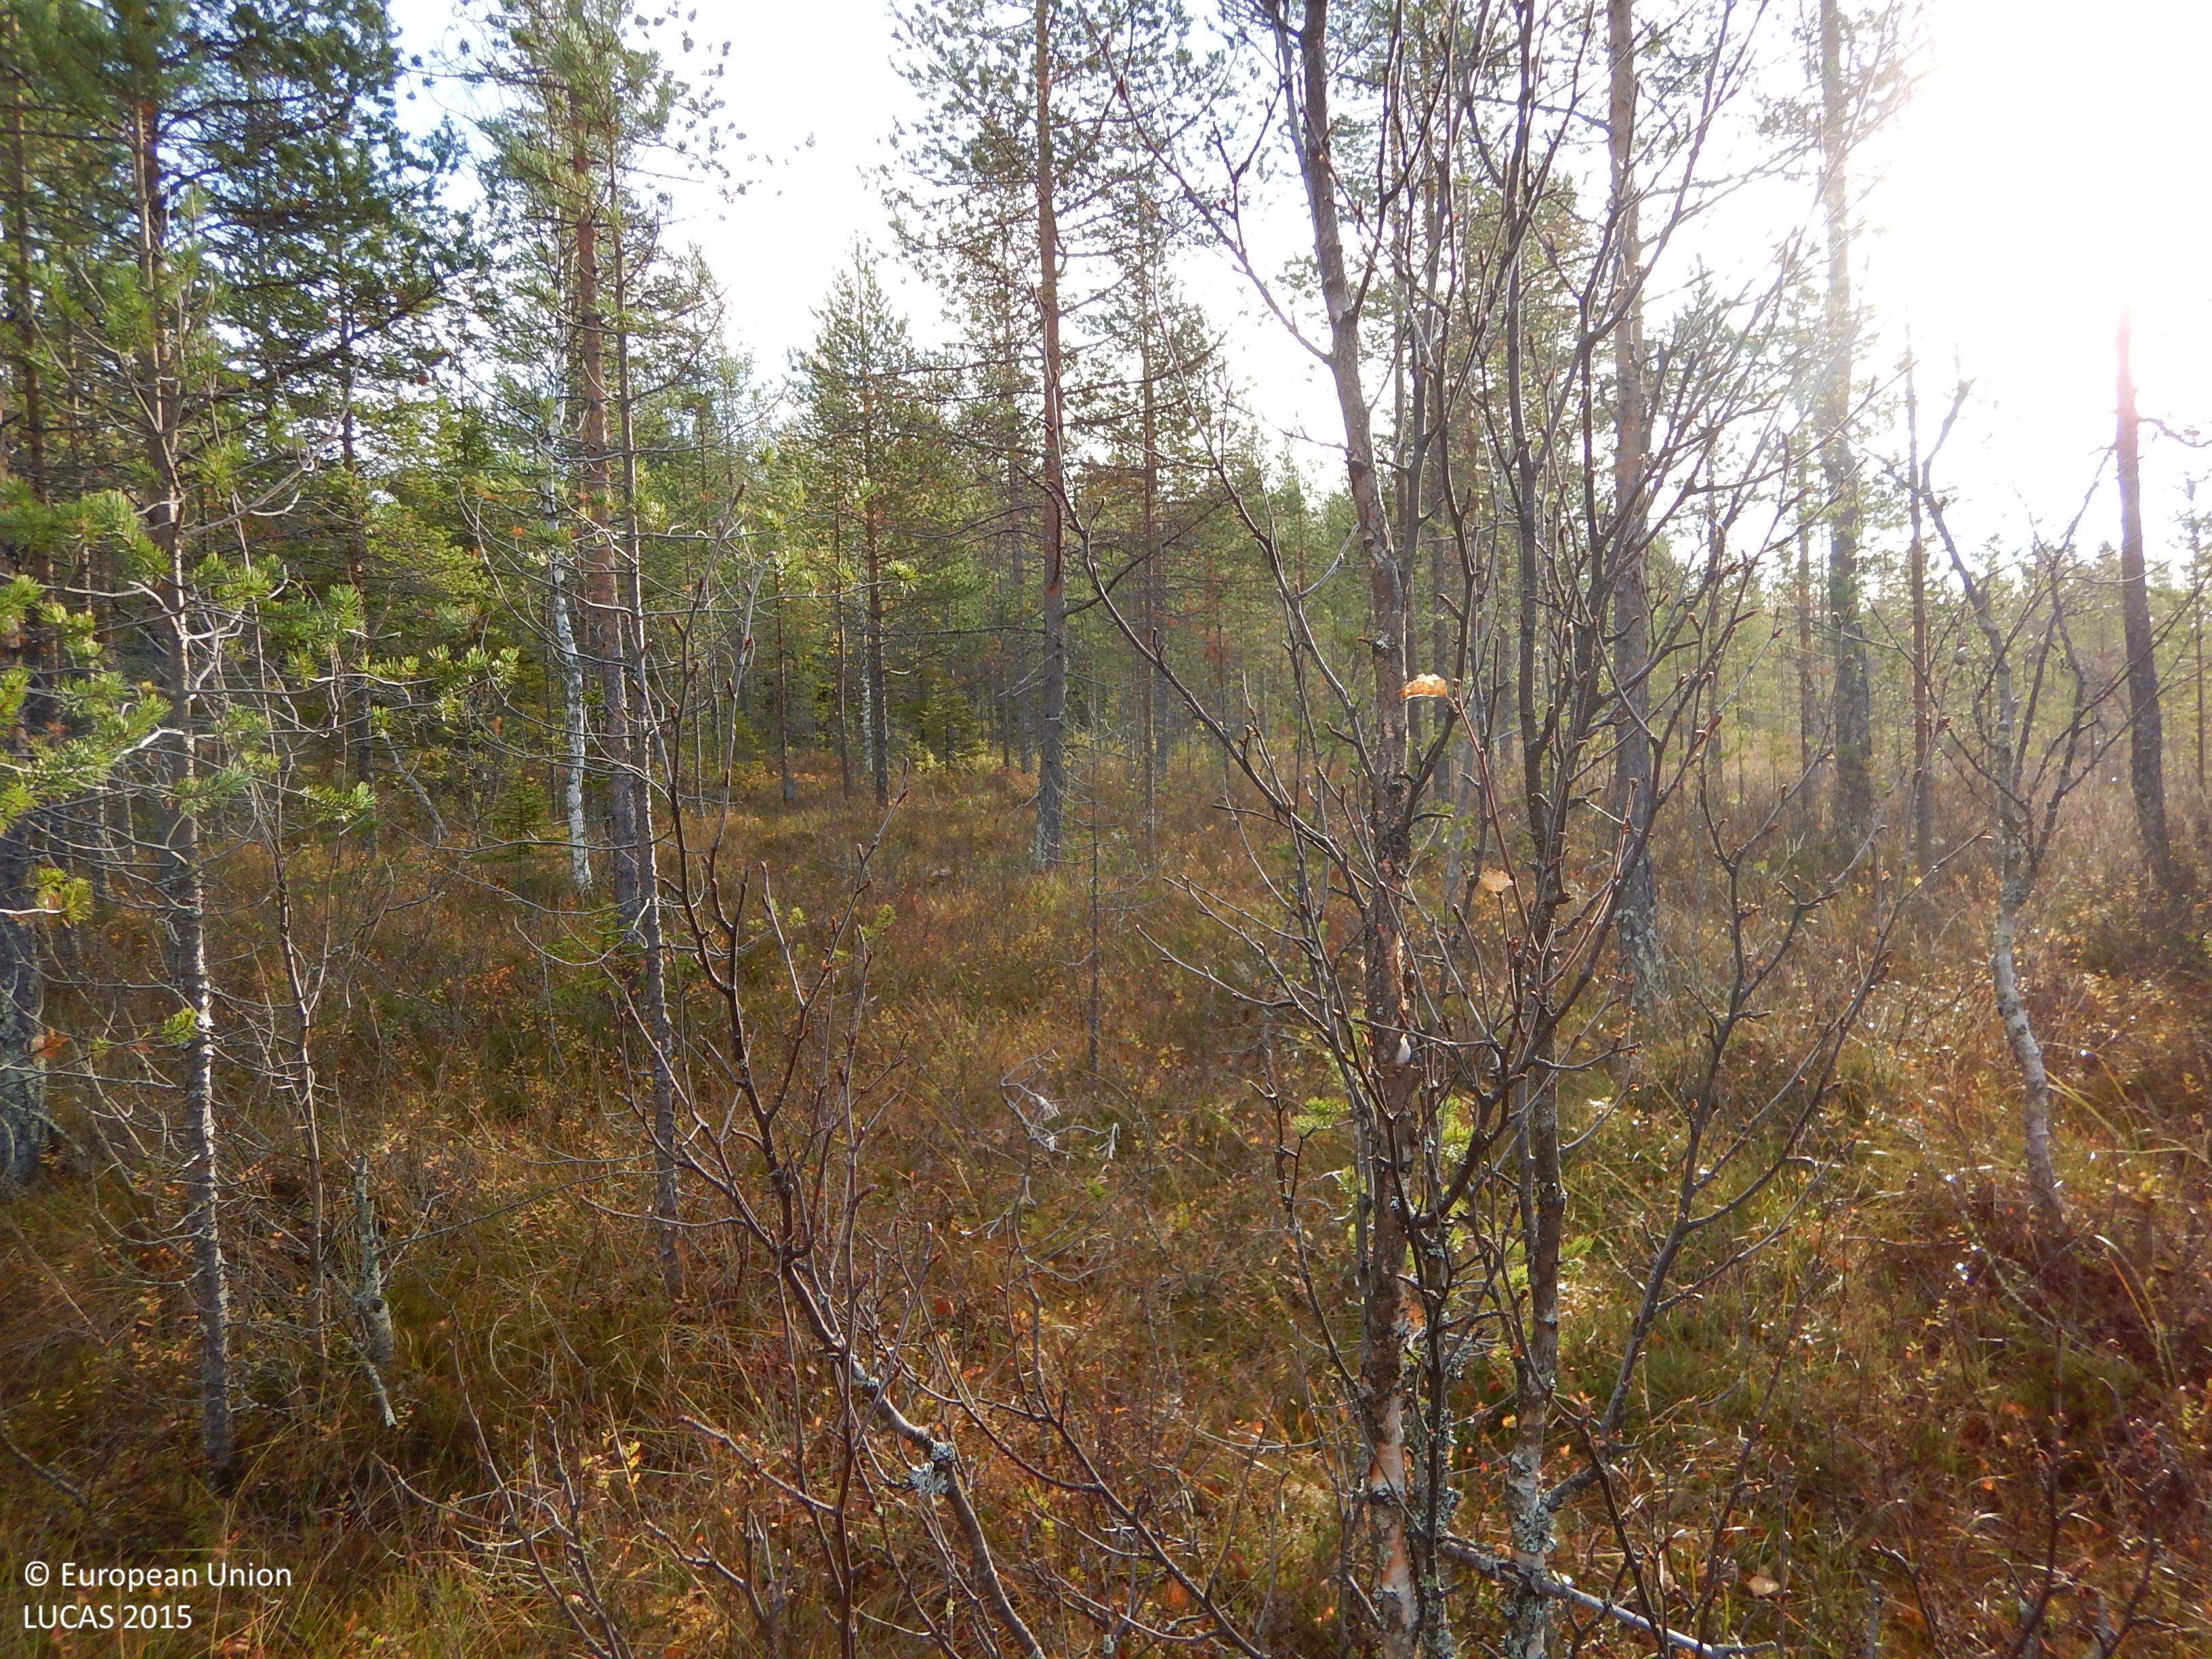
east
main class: Woodland
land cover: Pine dominated coniferous woodland
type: mire and swamp forests
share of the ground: 25 - 50 %
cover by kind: coniferous forest trees 40 %, lichens and mosses 25 %, shrubs 20 %, herbaceous plants 10 %, broadleaved forest trees 5 %
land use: Forestry
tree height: > 5 m
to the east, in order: Pine dominated coniferous woodland; Pine dominated mixed woodland; Spruce dominated mixed woodland; Spruce dominated coniferous woodland; Pine dominated coniferous woodland
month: October
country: SE
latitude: 65.0169
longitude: 20.7749
